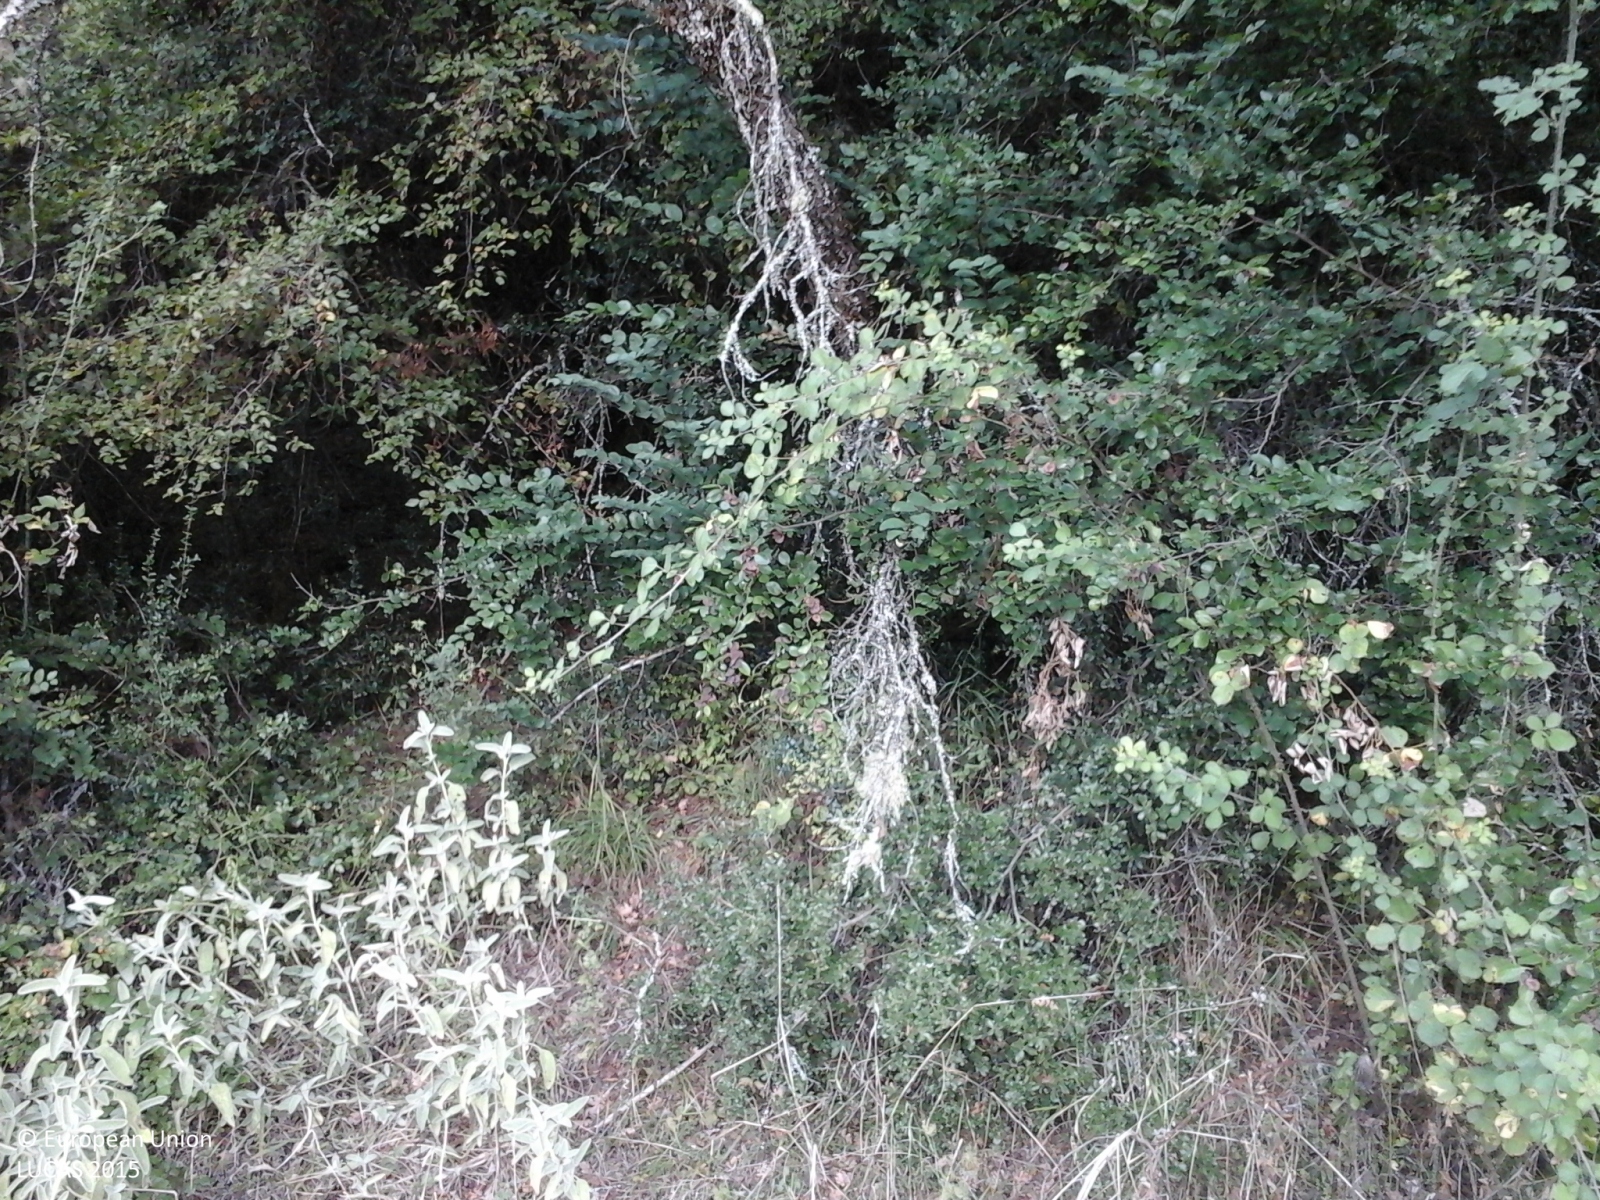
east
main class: Woodland
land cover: Broadleaved woodland
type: broadleaved evergreen forest
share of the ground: > 75 %
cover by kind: broadleaved forest trees 90 %, shrubs 10 %
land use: Semi-natural and natural areas not in use
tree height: > 5 m
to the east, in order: Broadleaved woodland; Paved roads, cycling and walking lanes; Broadleaved woodland; Electric lines; Broadleaved woodland; Paved roads, cycling and walking lanes; Broadleaved woodland
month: September
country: GR
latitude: 39.6914
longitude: 20.6005
